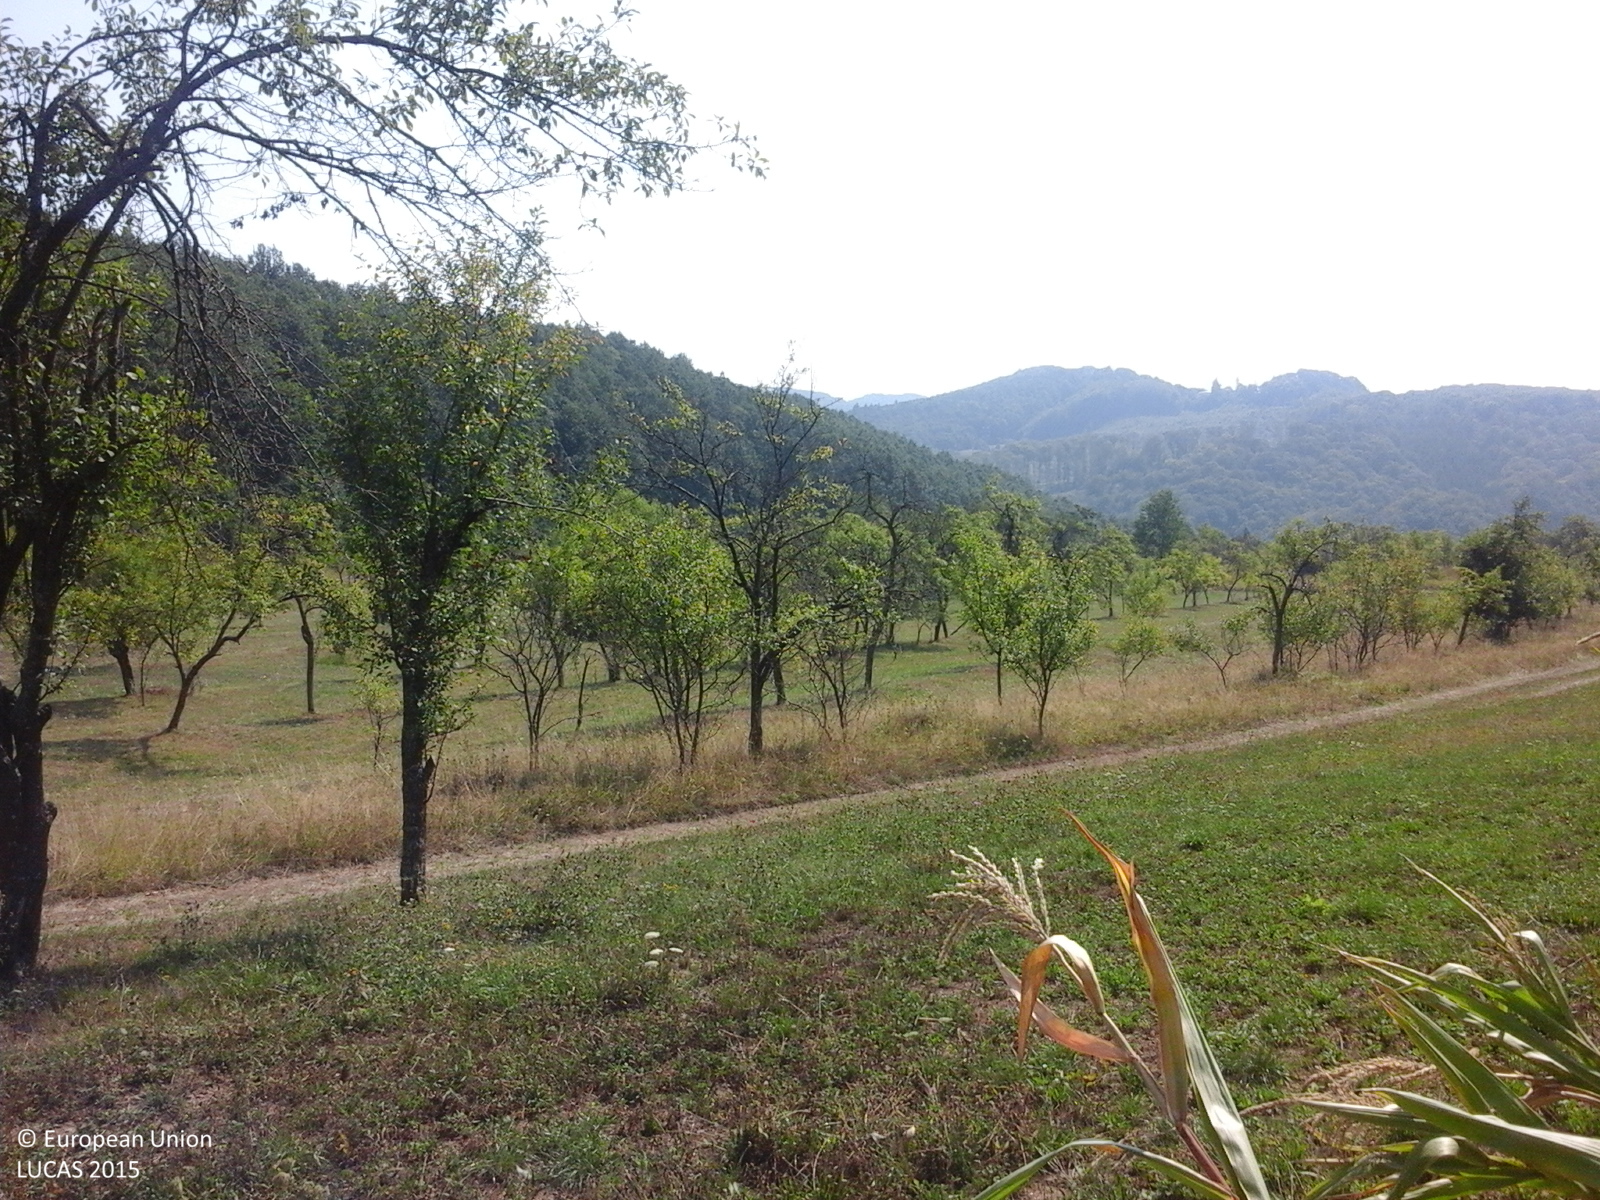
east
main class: Cropland
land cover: Maize
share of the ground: > 75 %
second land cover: Other fresh vegetables
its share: 25 - 50 %
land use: Agriculture (excluding fallow land and kitchen gardens)
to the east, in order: Maize; Other fresh vegetables; Grassland without tree/shrub cover; Lines of trees; Grass margins; Tracks; Grass margins; Other fruit trees and berries; Fences; Grassland with sparse tree/shrub cover; Broadleaved woodland
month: August
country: RO
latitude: 46.1429
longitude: 22.8056
